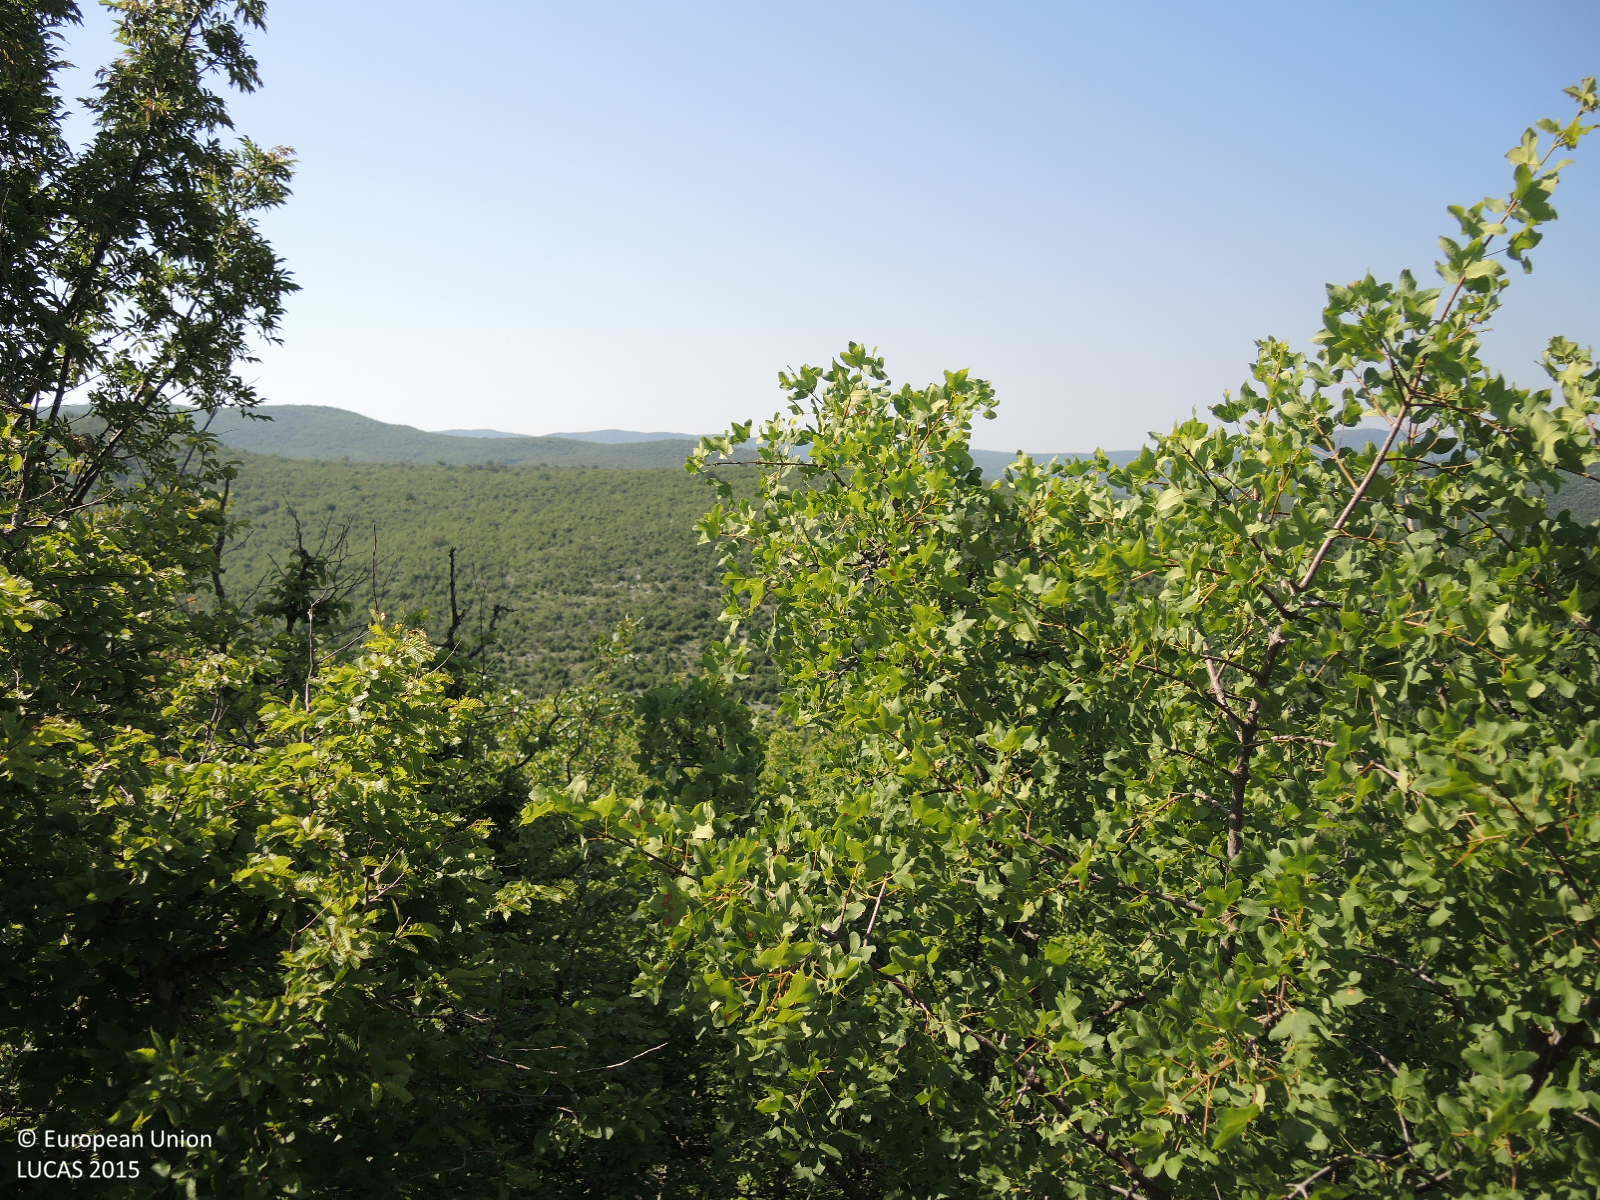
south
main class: Woodland
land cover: Broadleaved woodland
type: thermophilous deciduous forest
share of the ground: 50 - 75 %
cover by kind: broadleaved forest trees 50 %, consolidated bare surface 20 %, shrubs 15 %, unconsolidated bare surface 10 %, herbaceous plants 5 %
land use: Semi-natural and natural areas not in use
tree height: > 5 m
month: June
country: HR
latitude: 43.6539
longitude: 16.2775
